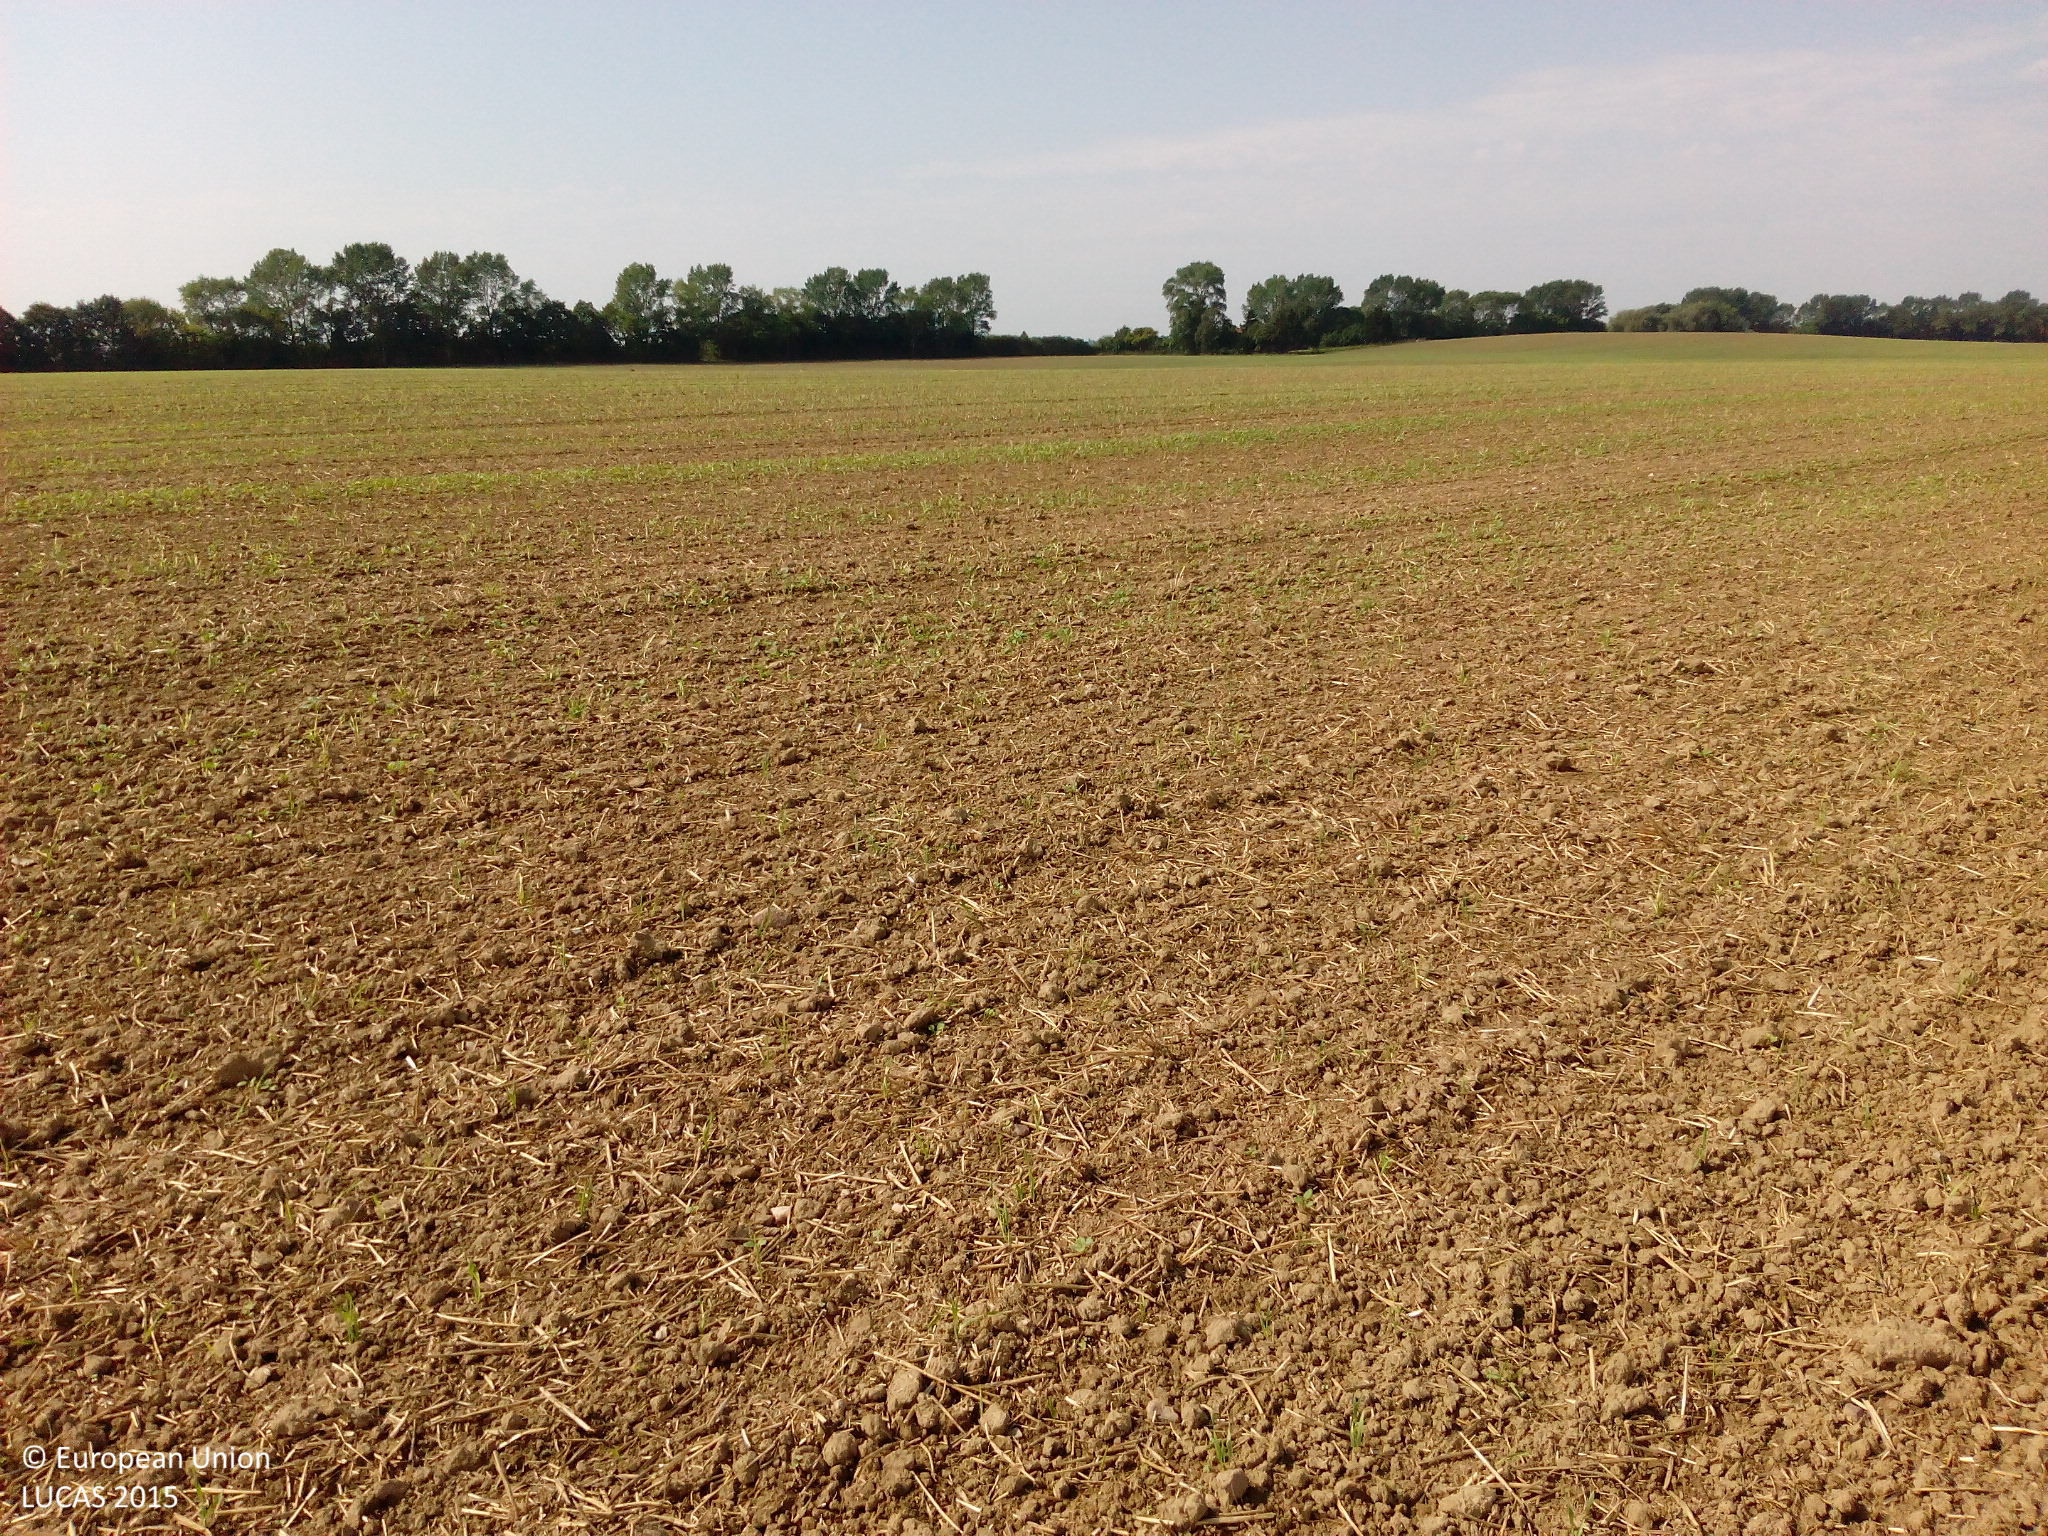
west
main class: Cropland
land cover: Rape and turnip rape
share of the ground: < 10 %
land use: Agriculture (excluding fallow land and kitchen gardens)
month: August
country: DE
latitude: 54.2367
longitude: 12.6226
